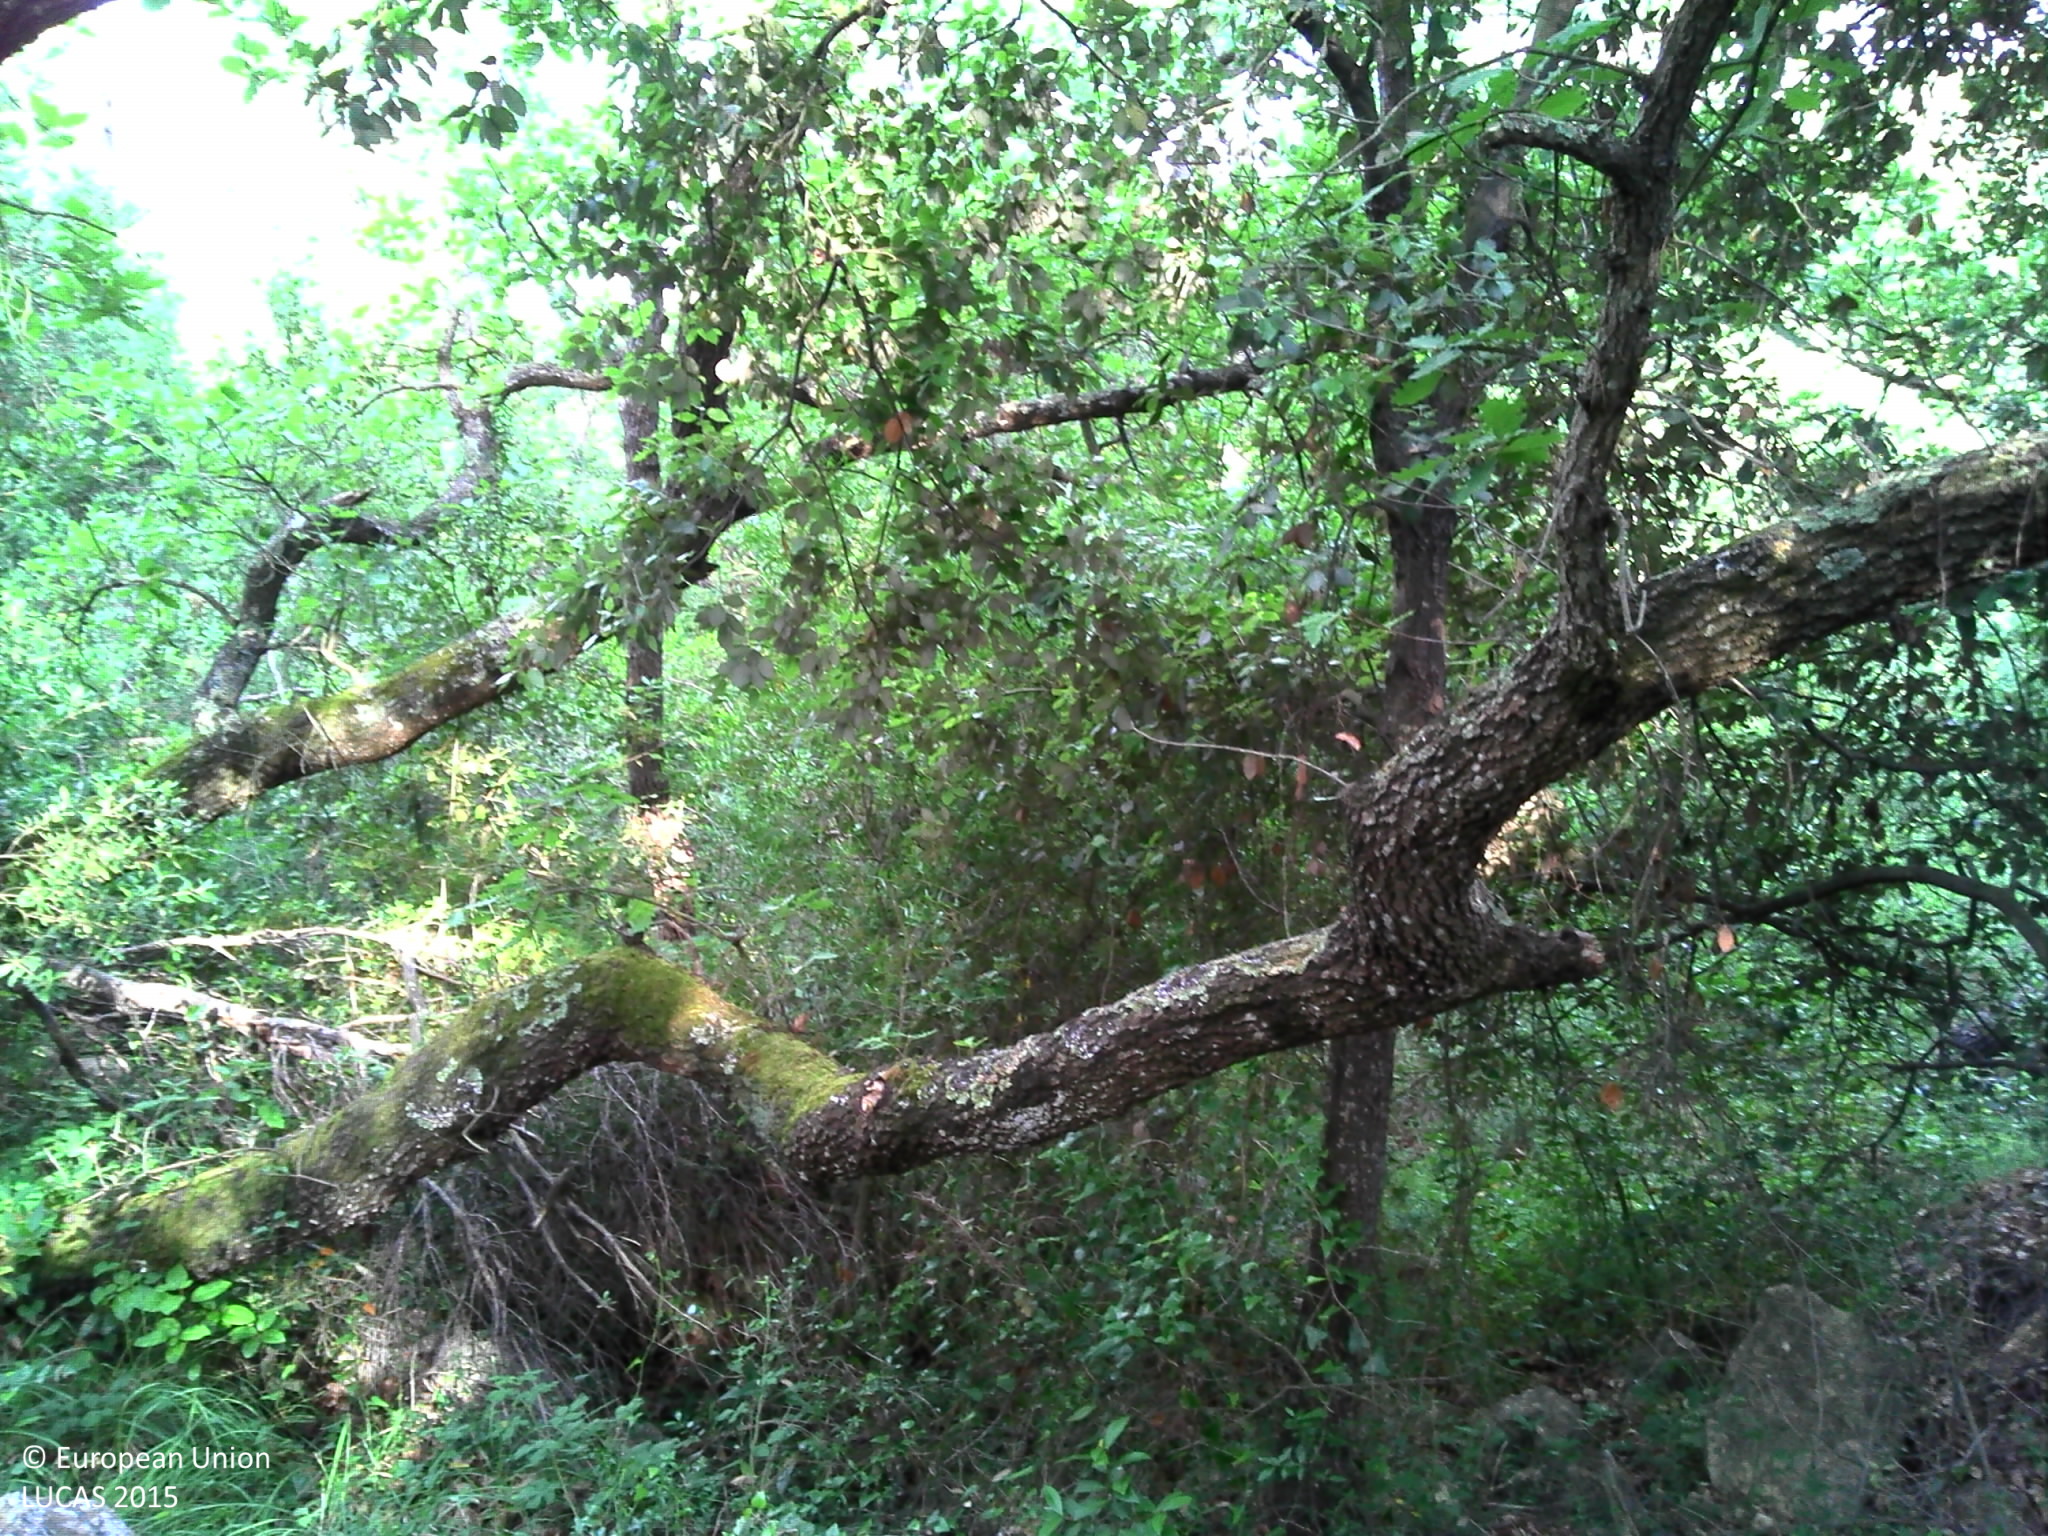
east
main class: Woodland
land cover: Pine dominated mixed woodland
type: thermophilous deciduous forest
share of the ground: > 75 %
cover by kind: broadleaved forest trees 45 %, coniferous forest trees 35 %, shrubs 15 %, herbaceous plants 5 %
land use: Forestry
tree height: > 5 m
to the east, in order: Pine dominated mixed woodland; Fences; Pine dominated mixed woodland; Shrubland with sparse tree cover; Fences; Pine dominated mixed woodland
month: June
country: FR
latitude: 43.6399
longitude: 7.0198
